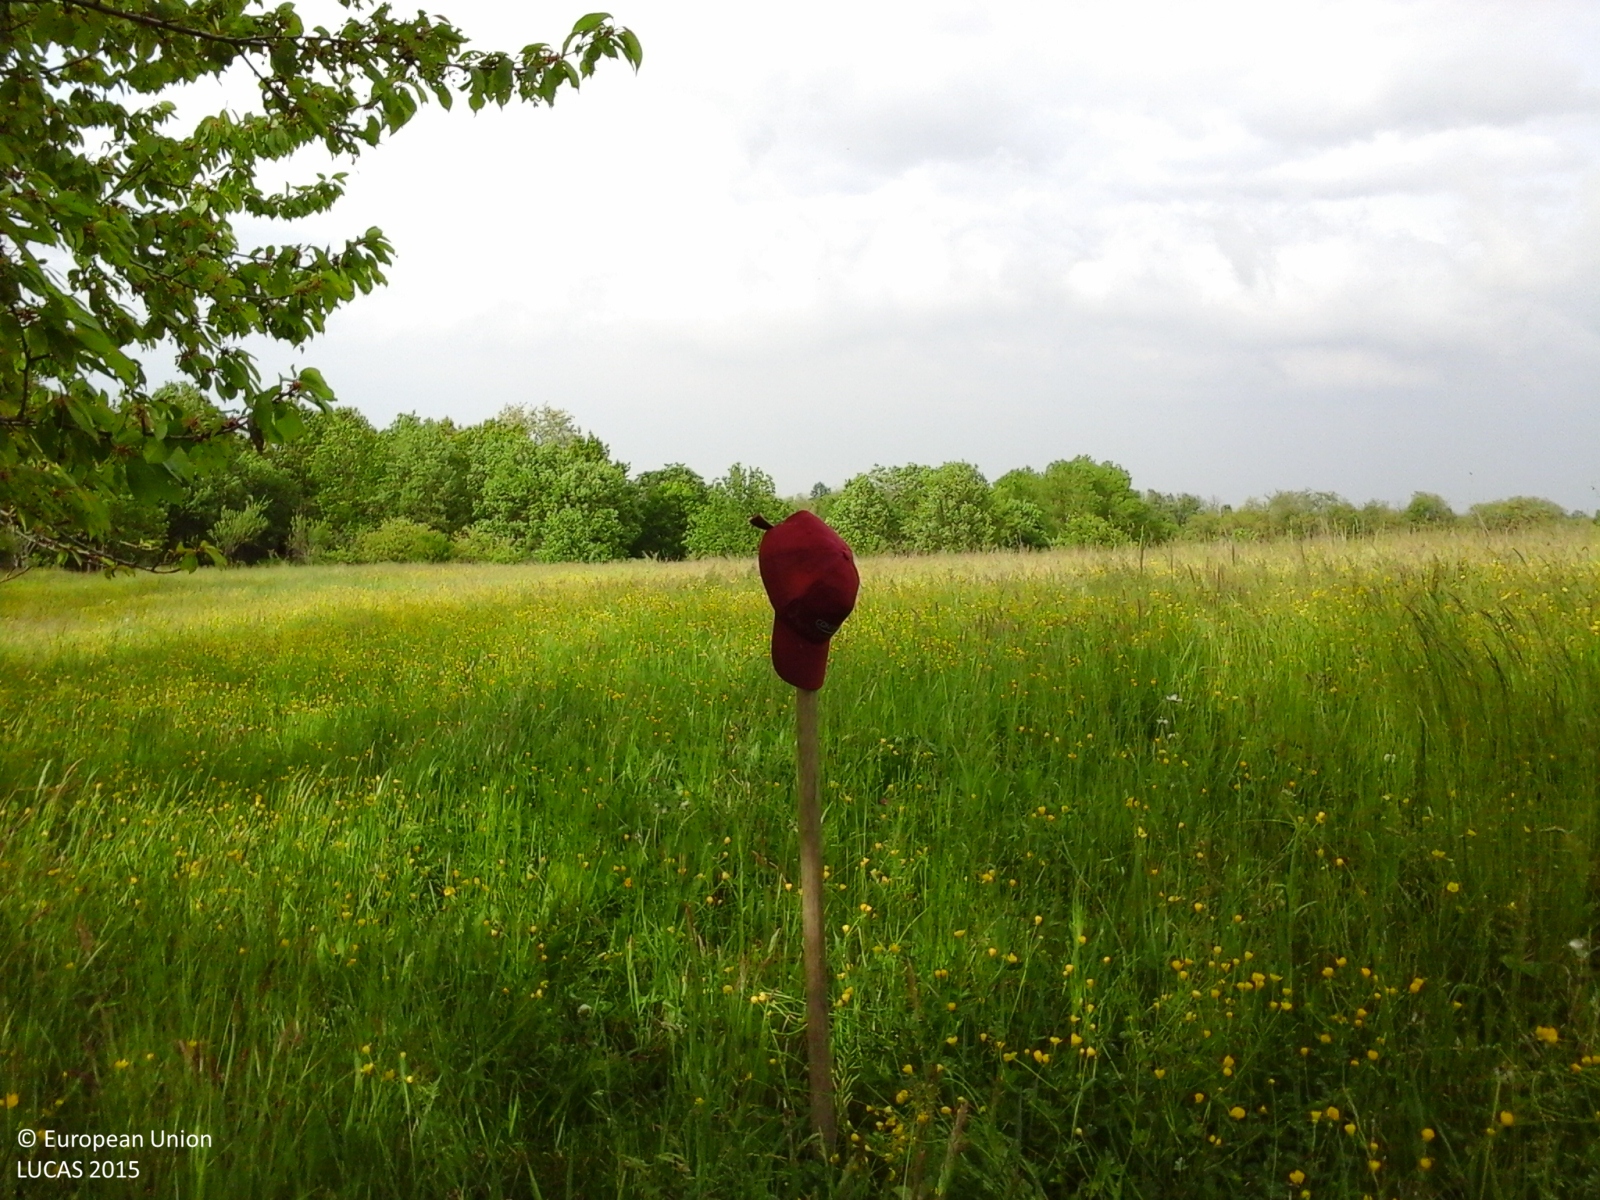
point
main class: Woodland
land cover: Broadleaved woodland
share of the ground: > 75 %
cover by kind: broadleaved forest trees 80 %, shrubs 15 %, herbaceous plants 5 %
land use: Semi-natural and natural areas not in use
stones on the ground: < 10 %
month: May
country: IT
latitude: 44.9267
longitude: 9.5574
